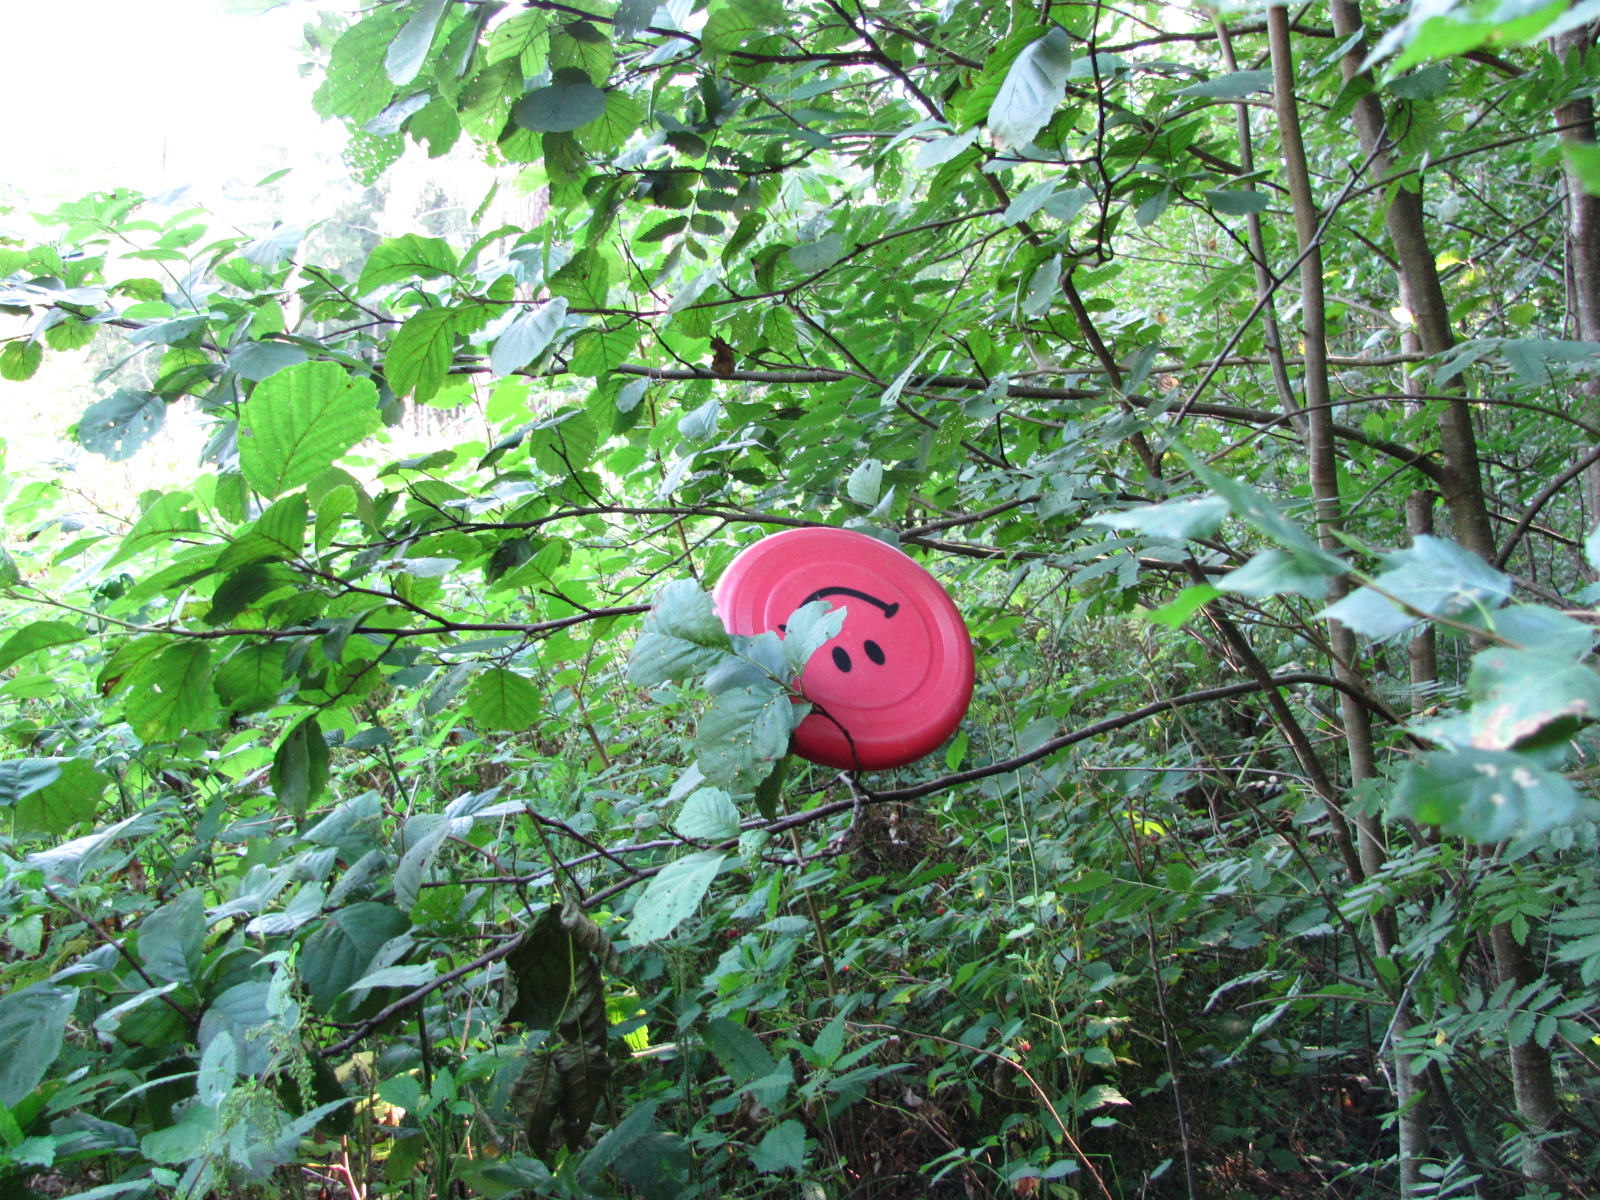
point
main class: Woodland
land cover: Broadleaved woodland
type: non-riverine alder, birch or aspen forest
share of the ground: > 75 %
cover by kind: broadleaved forest trees 85 %, herbaceous plants 15 %
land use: Forestry
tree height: > 5 m
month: August
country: LV
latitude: 56.6688
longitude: 23.9037
